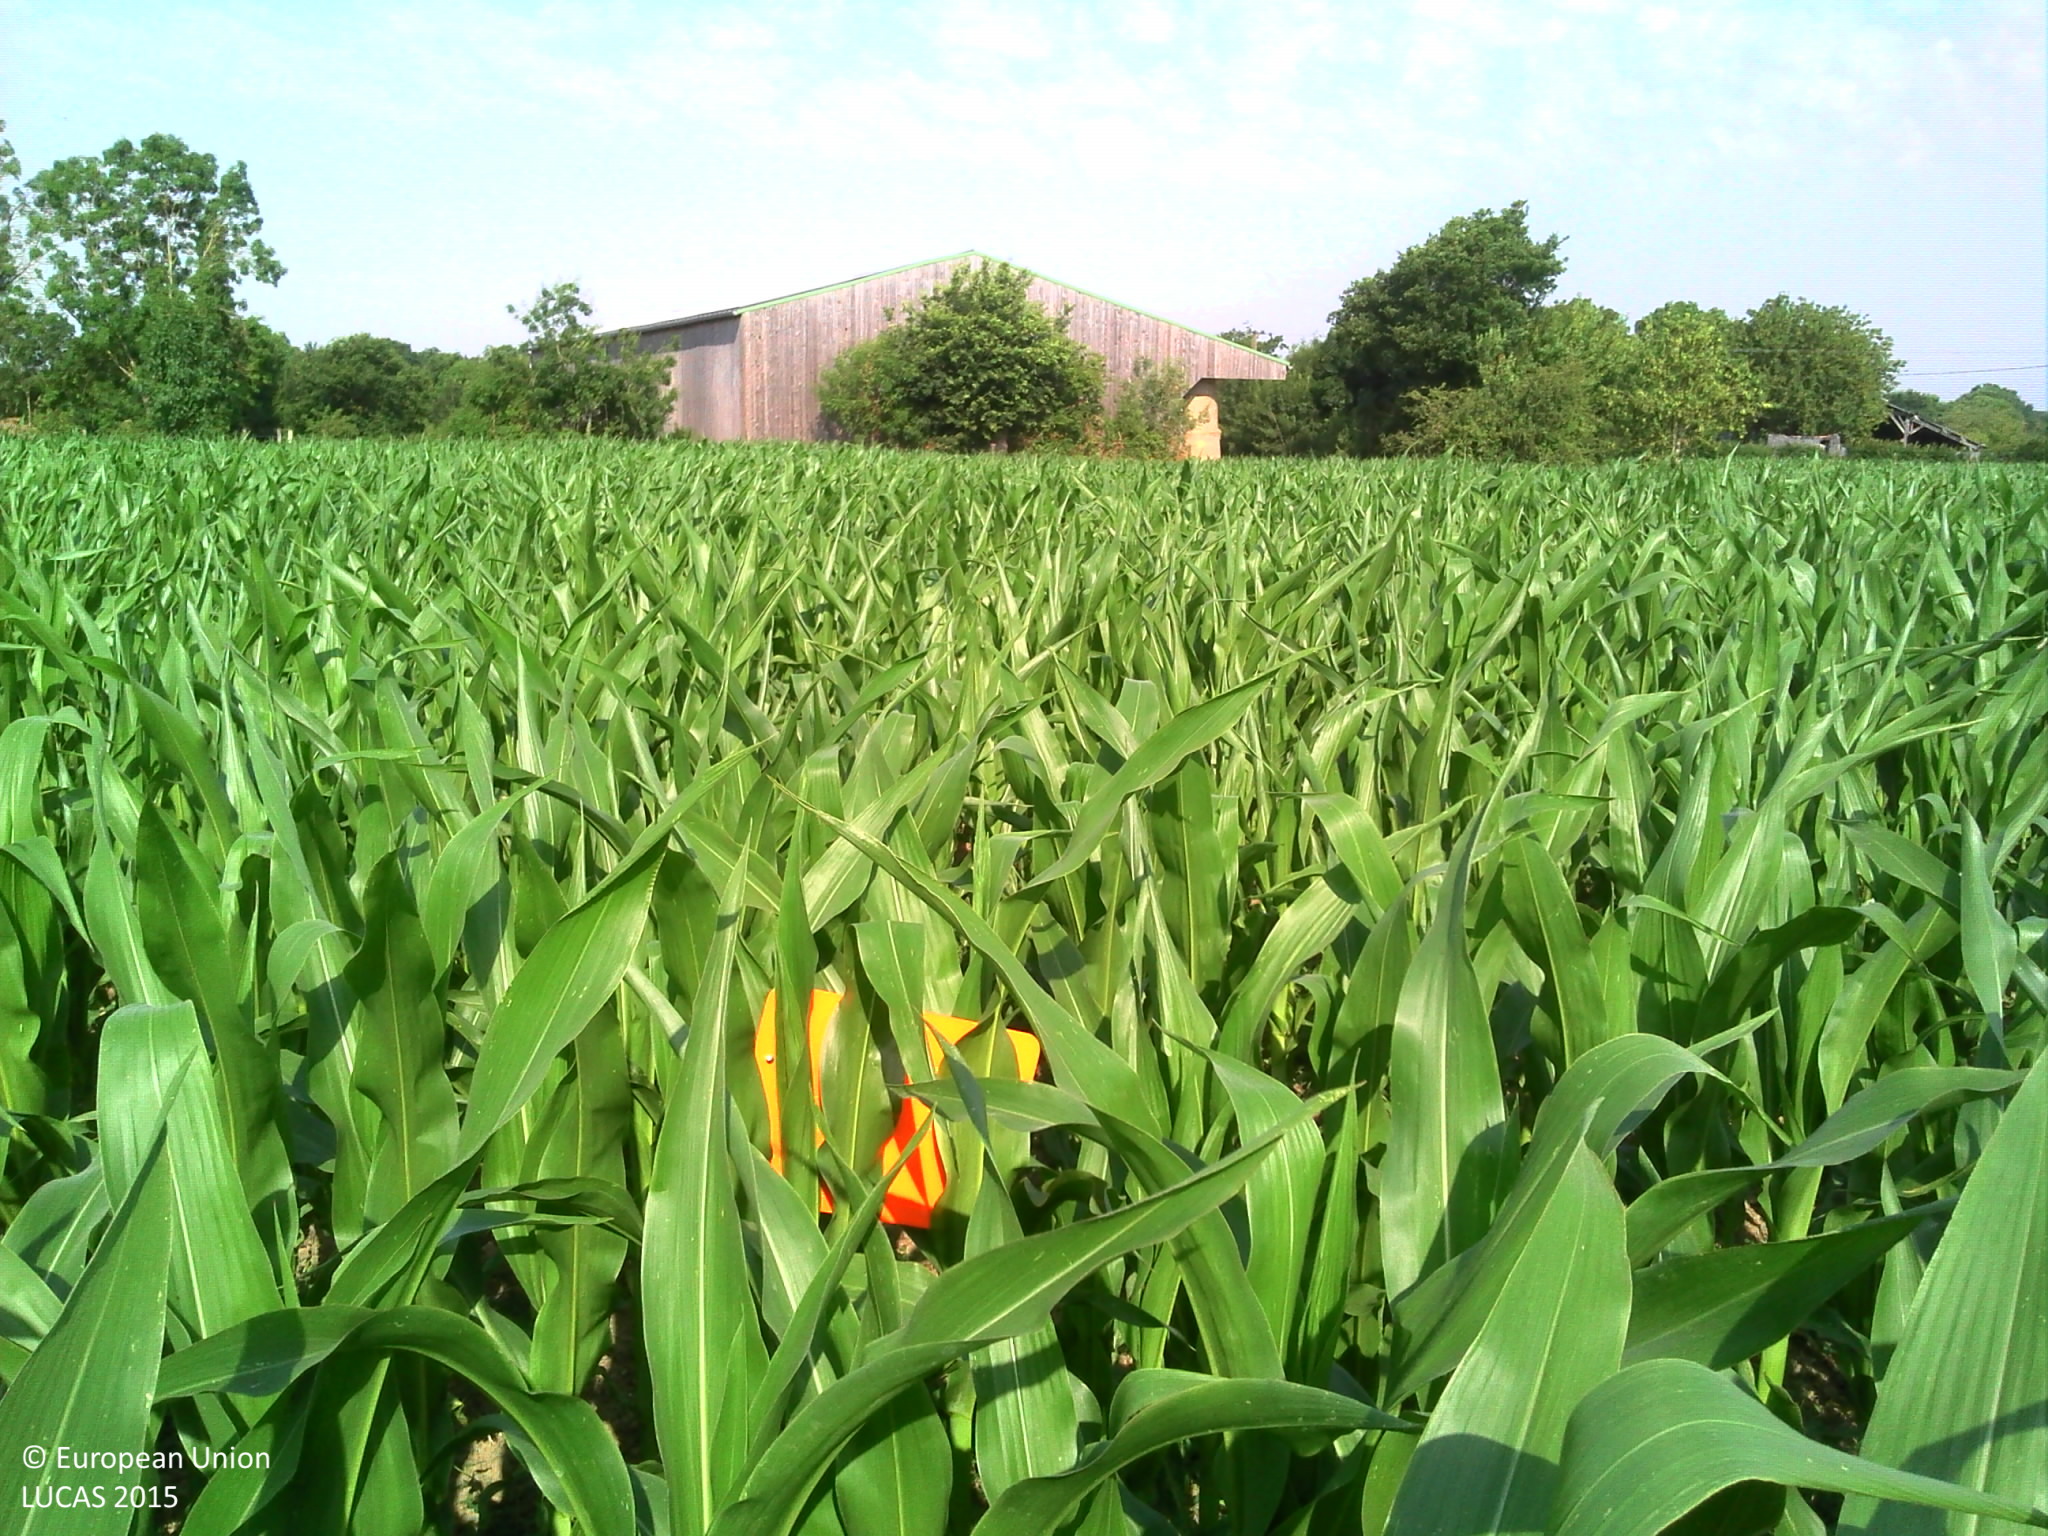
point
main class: Cropland
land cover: Maize
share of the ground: > 75 %
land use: Agriculture (excluding fallow land and kitchen gardens)
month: July
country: FR
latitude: 47.3172
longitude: -1.9411
